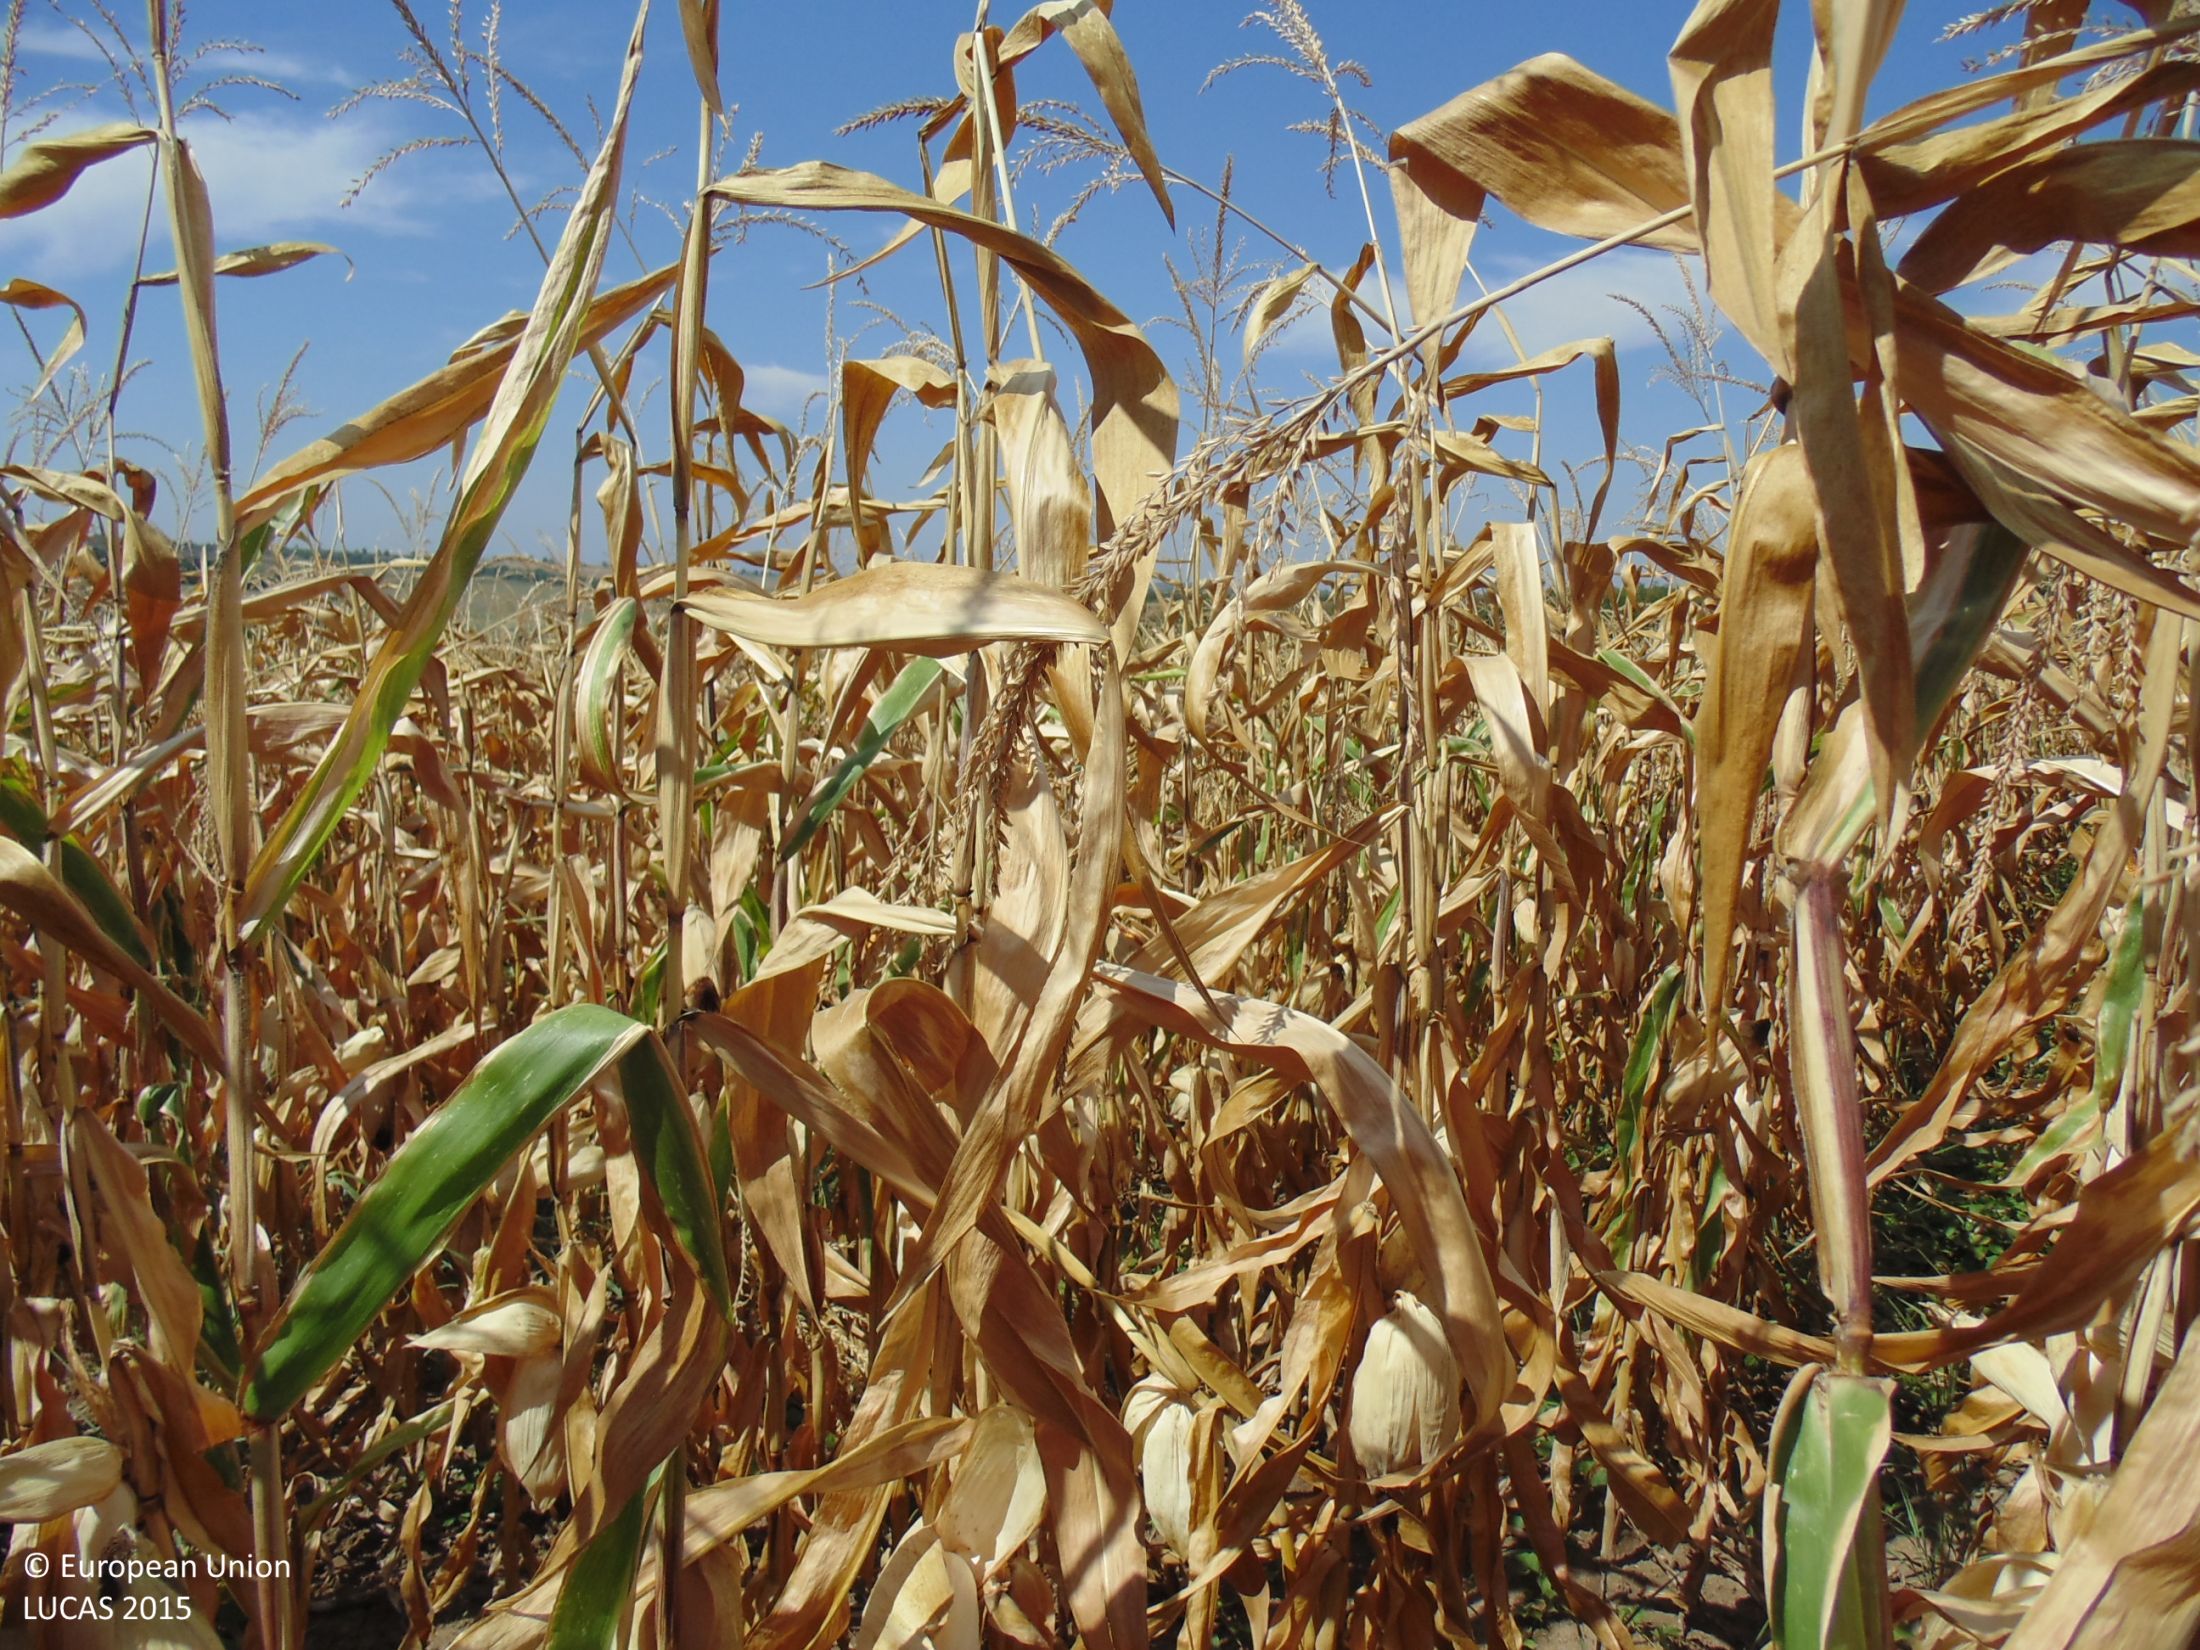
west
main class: Cropland
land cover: Maize
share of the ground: > 75 %
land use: Agriculture (excluding fallow land and kitchen gardens)
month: September
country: BG
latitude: 43.9125
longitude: 27.0978
